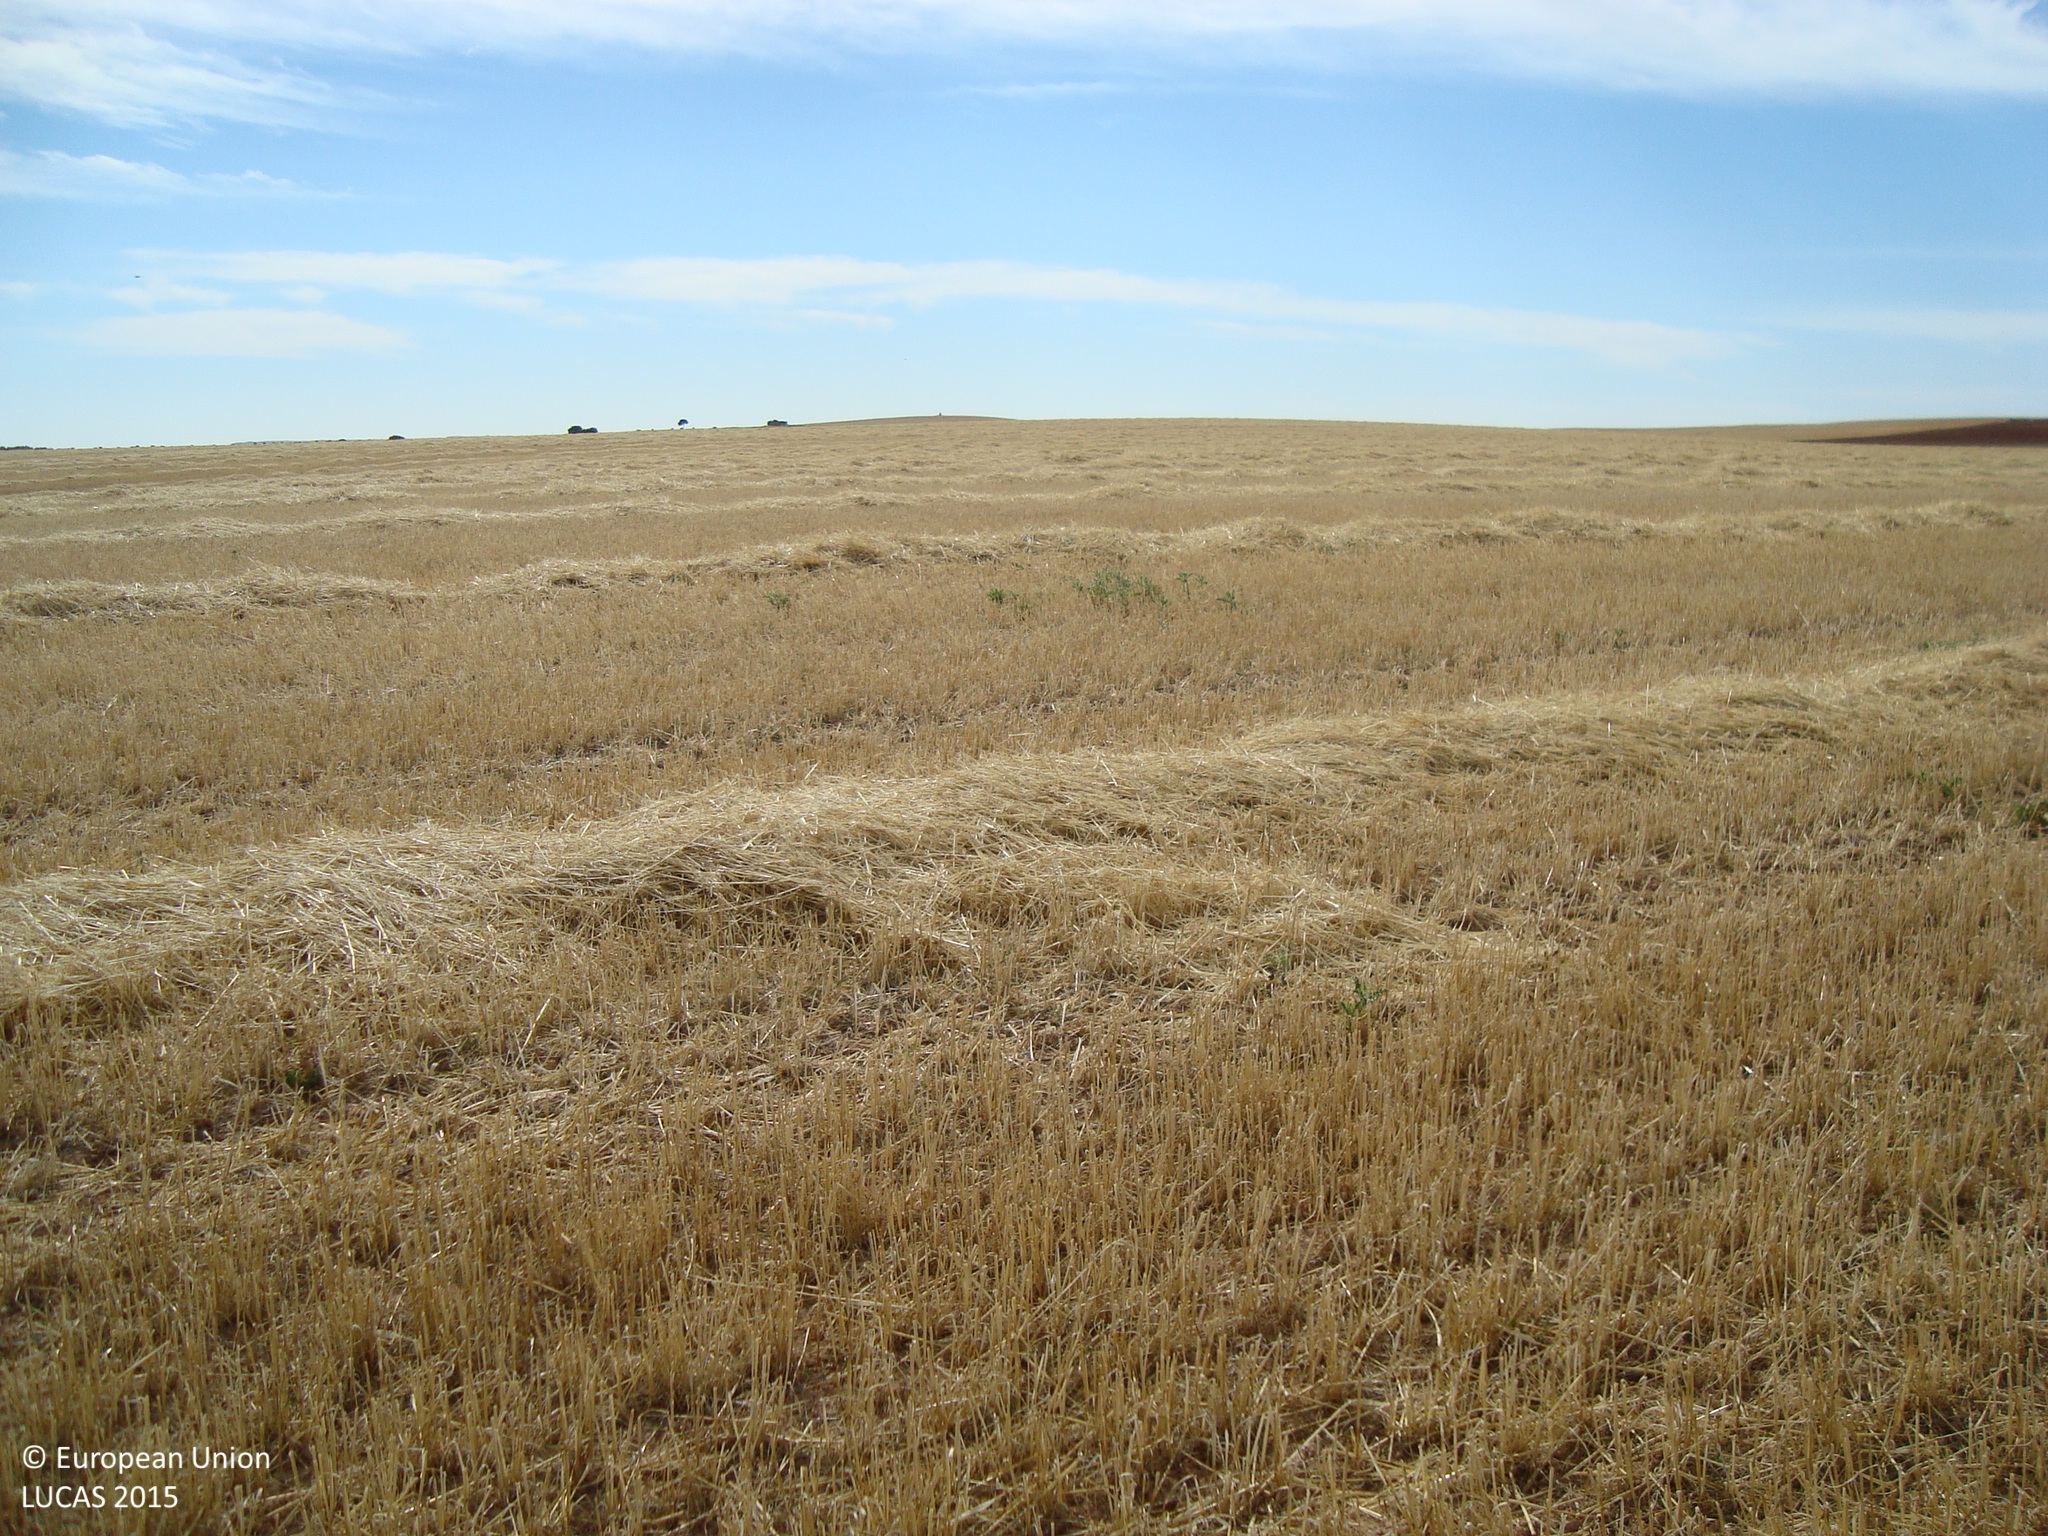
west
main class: Cropland
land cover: Barley
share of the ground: > 75 %
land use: Agriculture (excluding fallow land and kitchen gardens)
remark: Harvested field
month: July
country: ES
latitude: 42.1344
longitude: -3.8649
